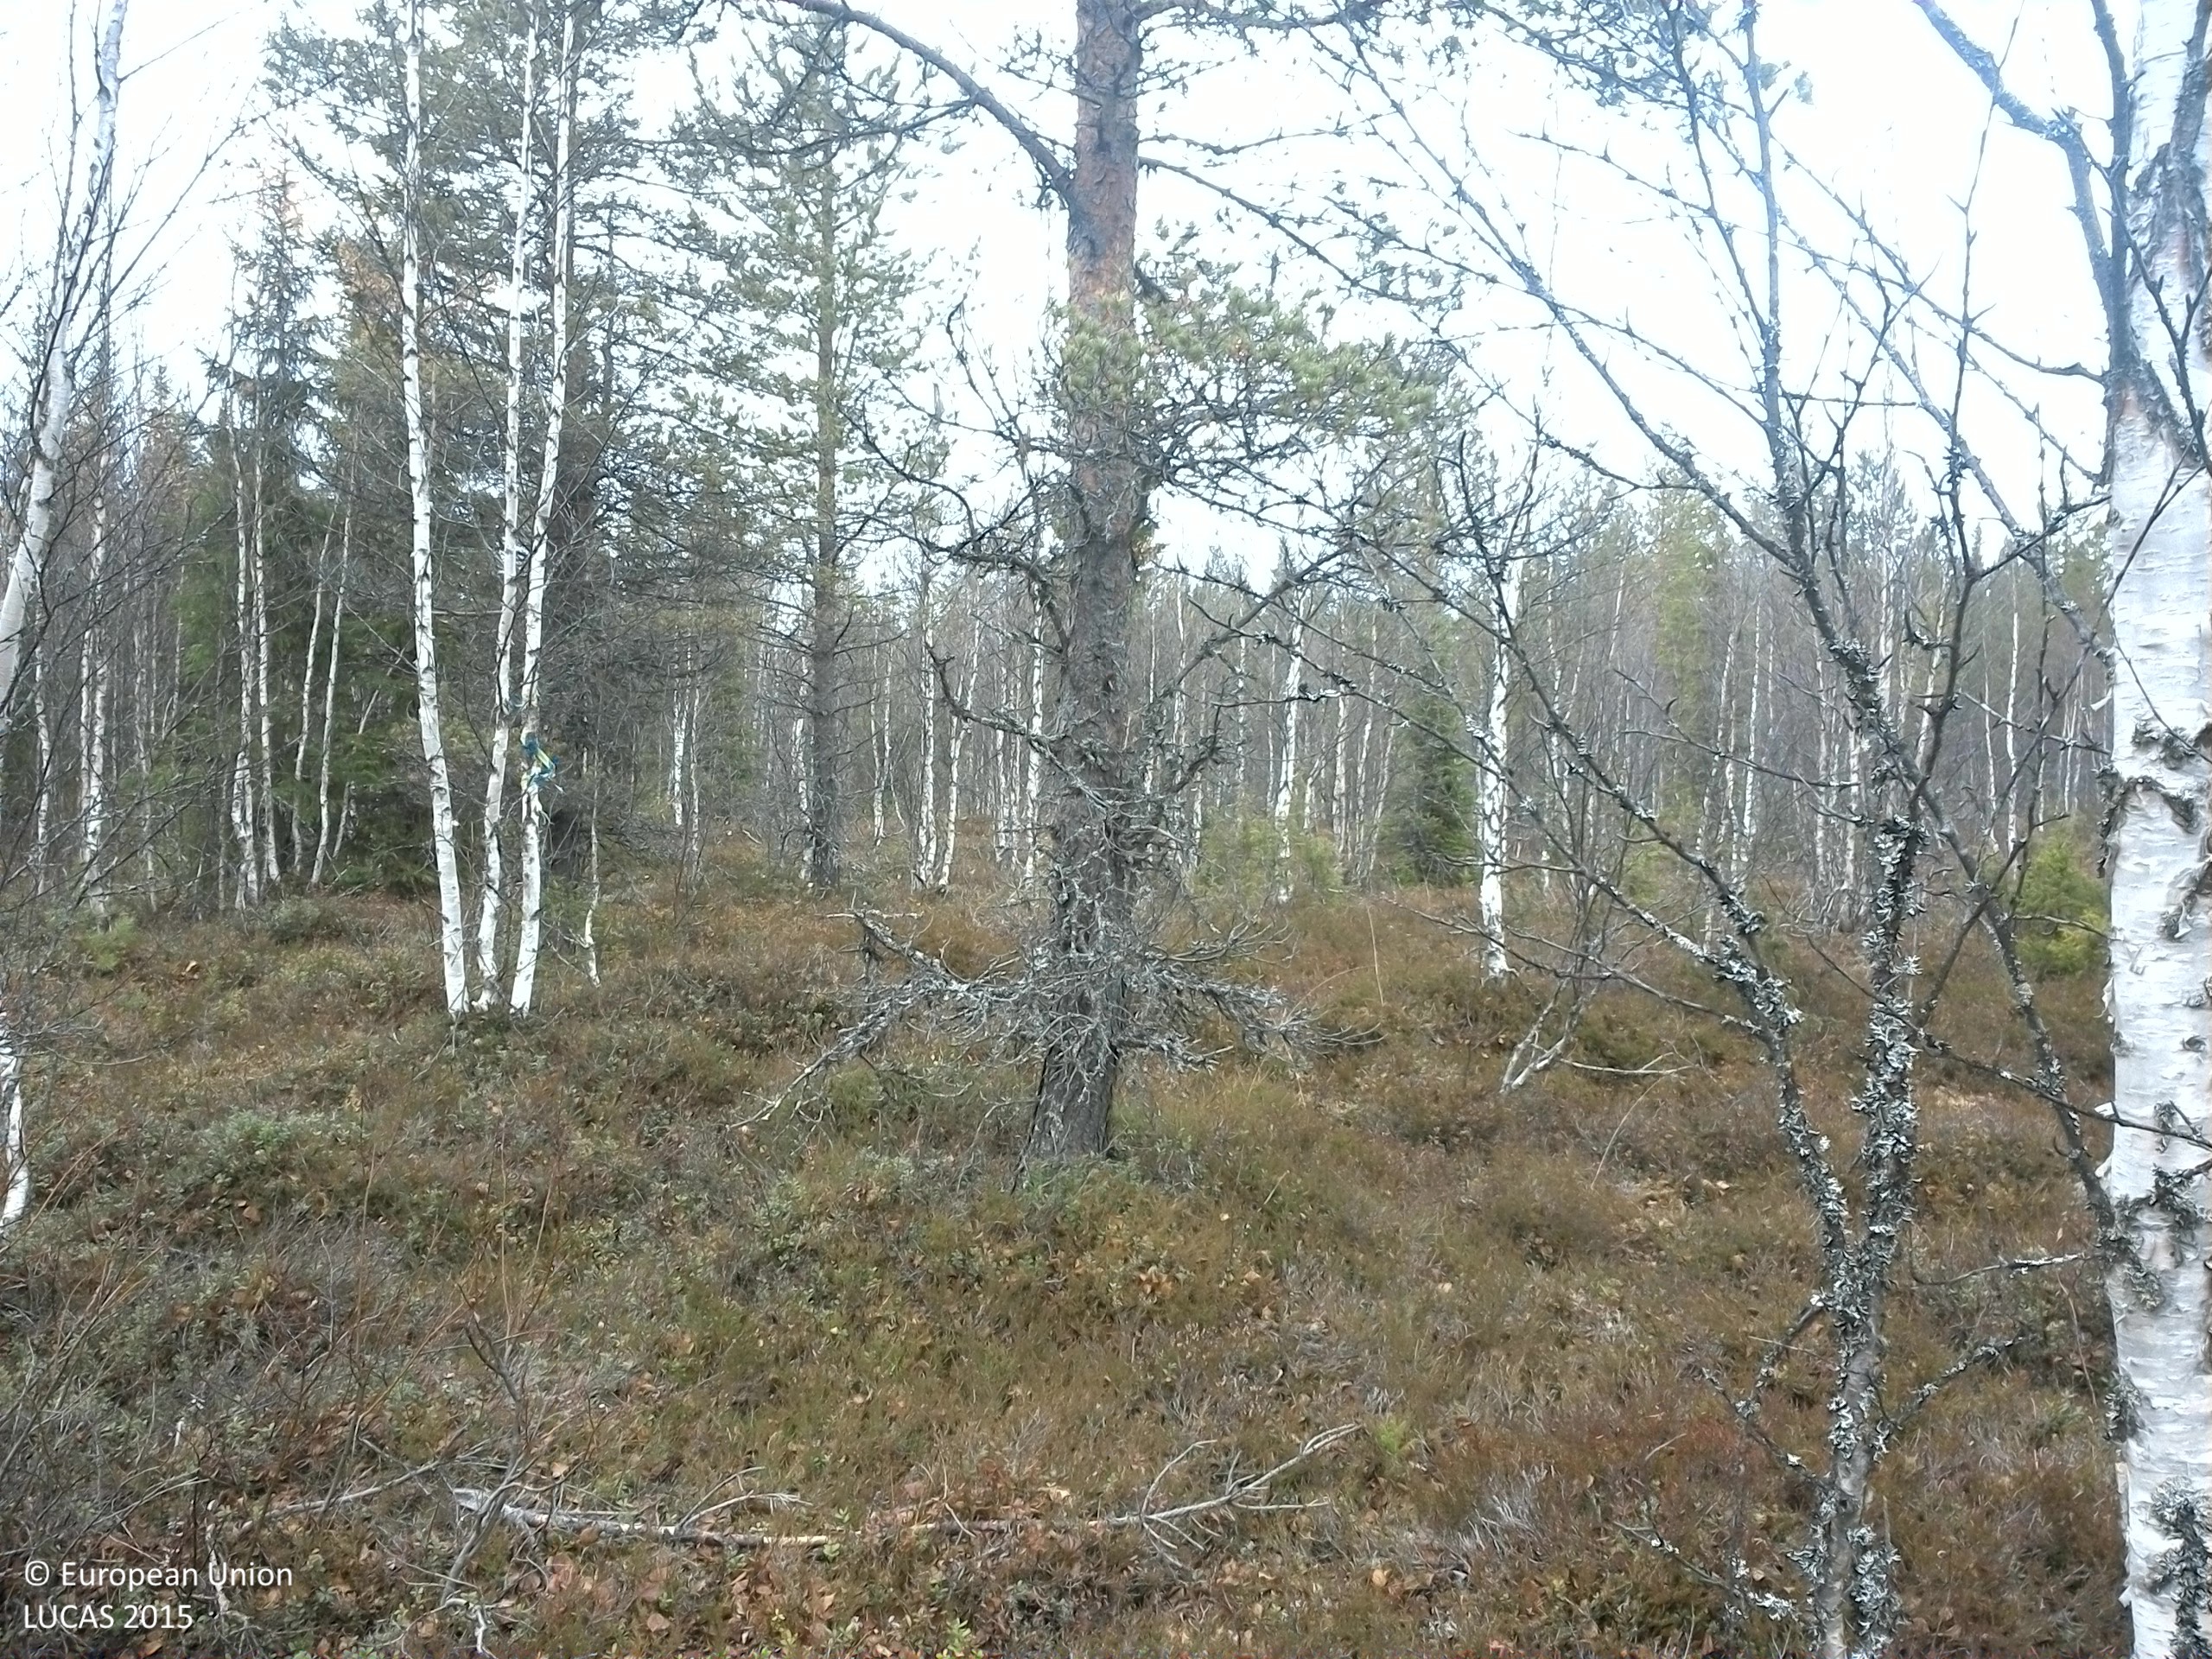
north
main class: Woodland
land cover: Spruce dominated mixed woodland
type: boreal forest
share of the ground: 25 - 50 %
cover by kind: shrubs 45 %, broadleaved forest trees 30 %, lichens and mosses 15 %, coniferous forest trees 10 %
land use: Forestry
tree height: > 5 m
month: October
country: SE
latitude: 64.2643
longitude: 15.5649
